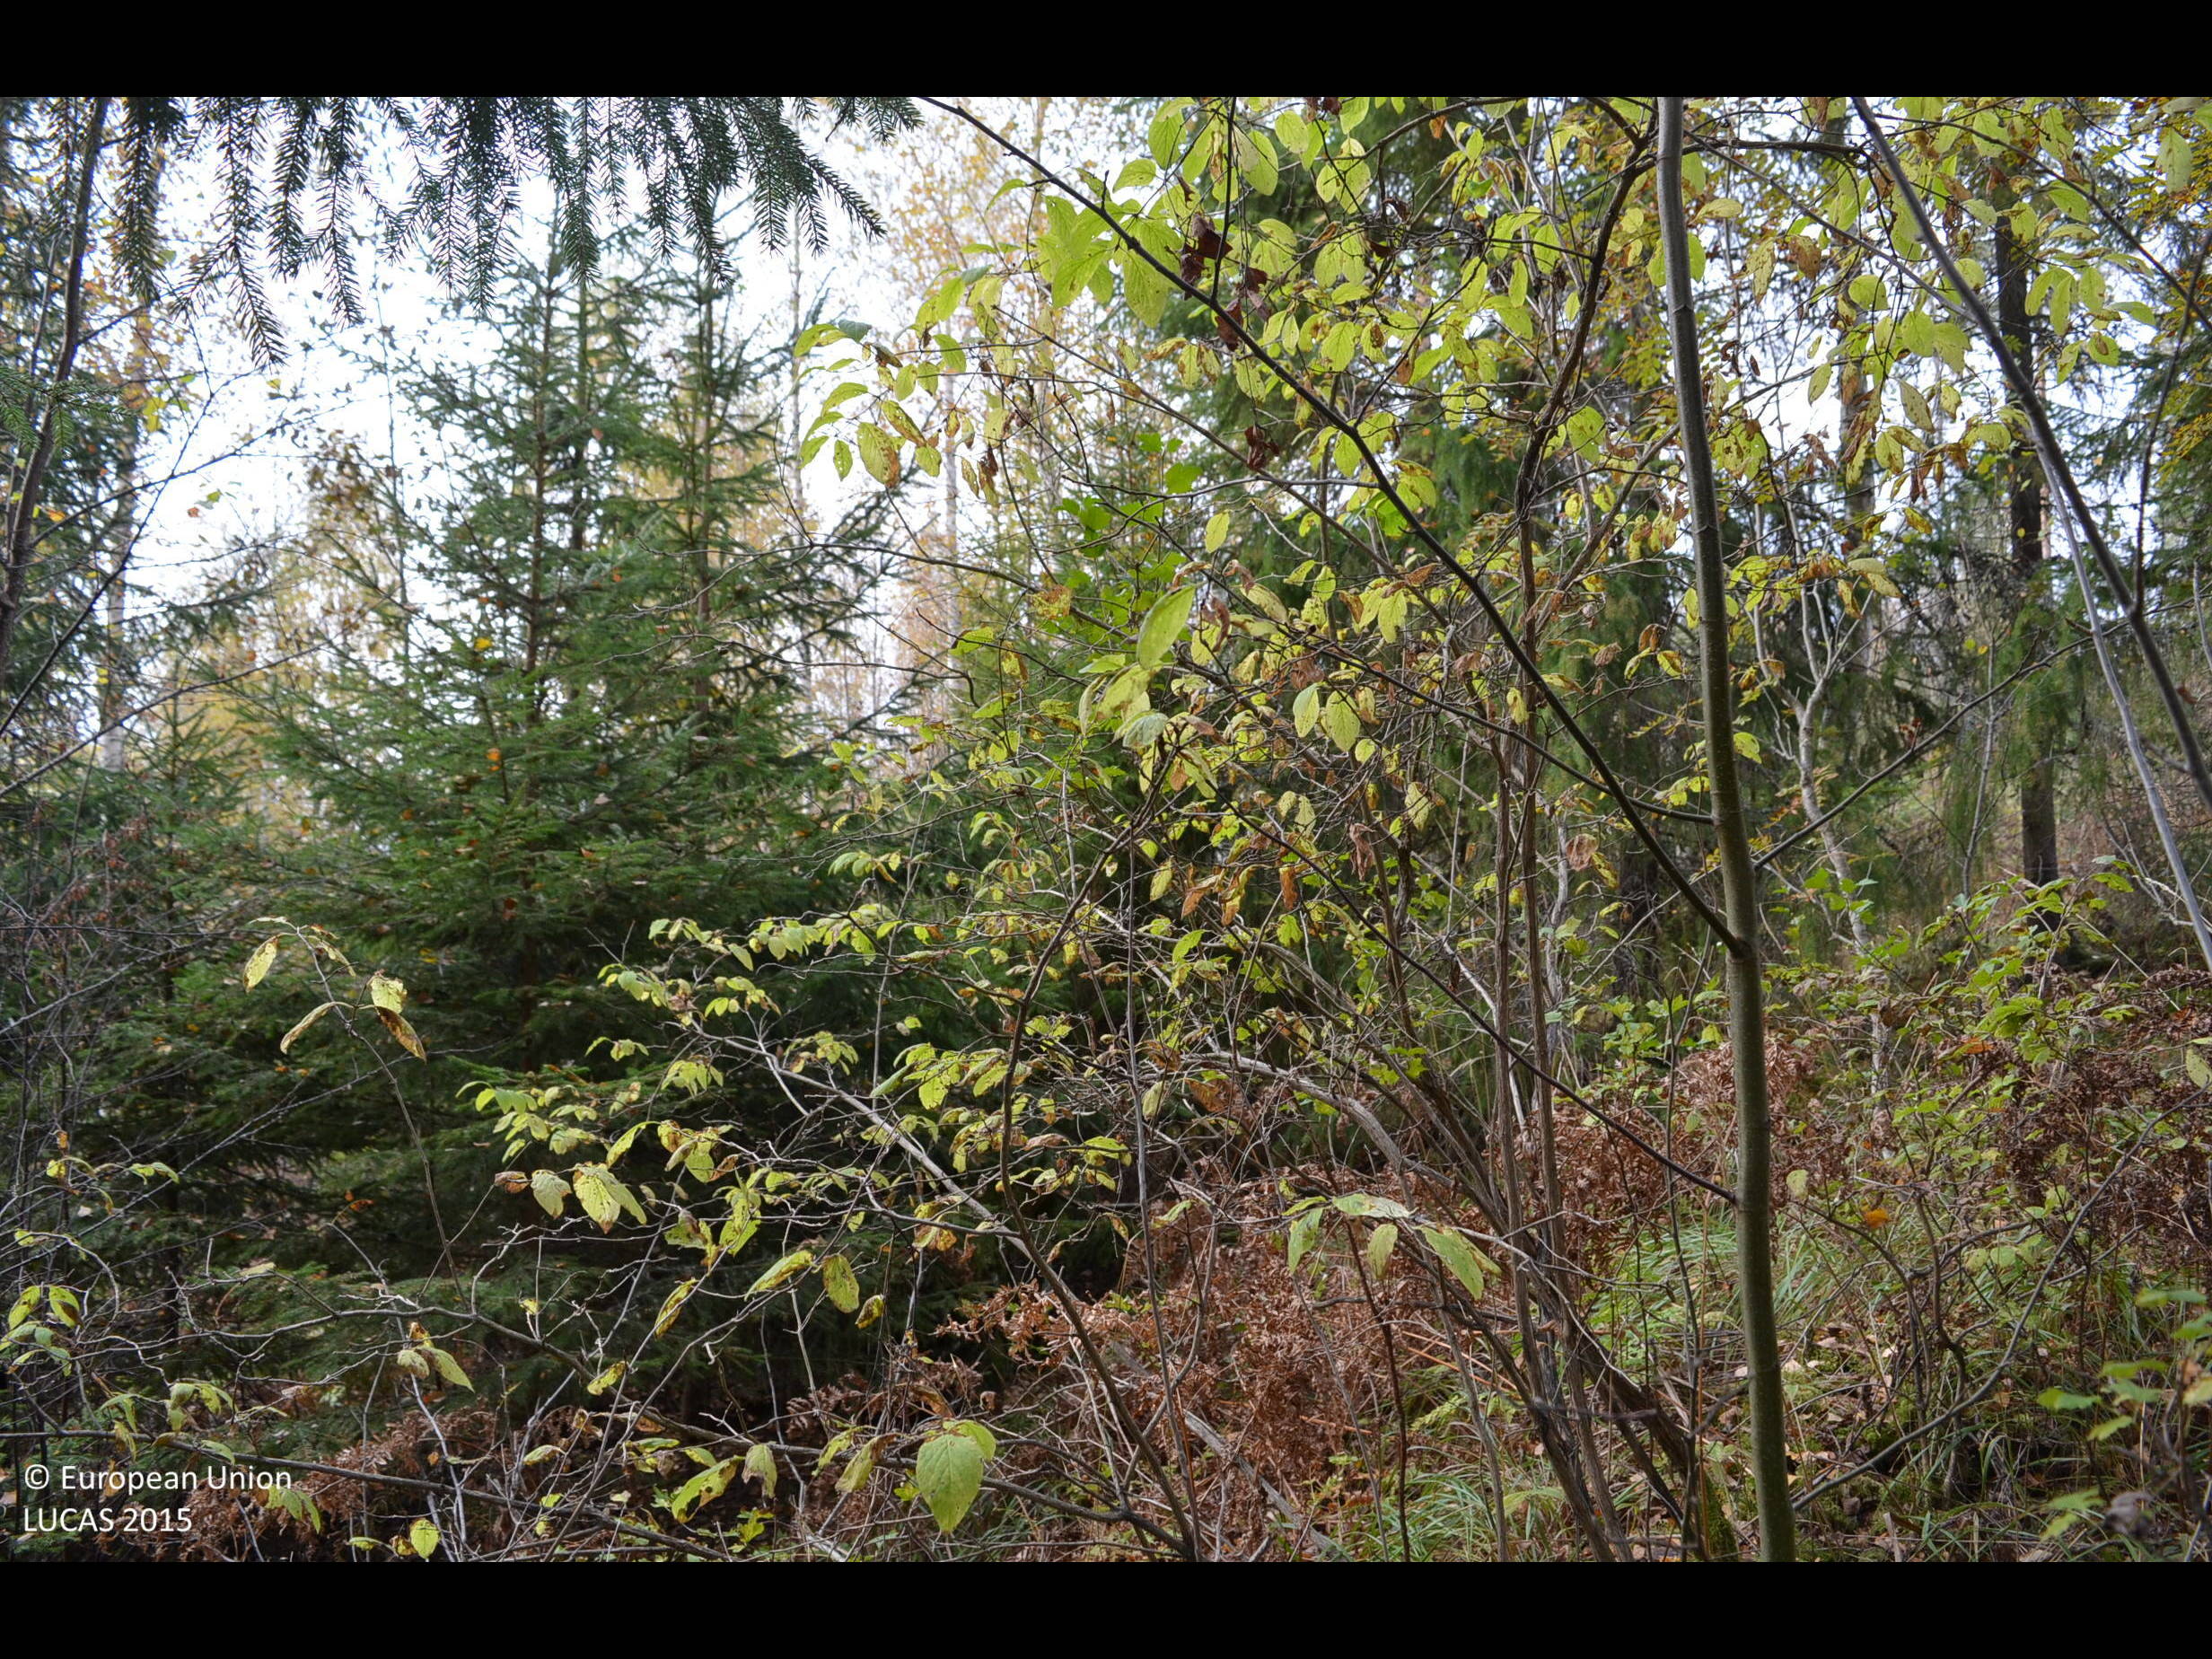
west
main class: Woodland
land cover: Spruce dominated mixed woodland
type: boreal forest
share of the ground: 50 - 75 %
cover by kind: broadleaved forest trees 35 %, coniferous forest trees 25 %, shrubs 10 %, herbaceous plants 10 %, lichens and mosses 10 %
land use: Forestry
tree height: > 5 m
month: October
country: FI
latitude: 61.4786
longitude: 23.1973
